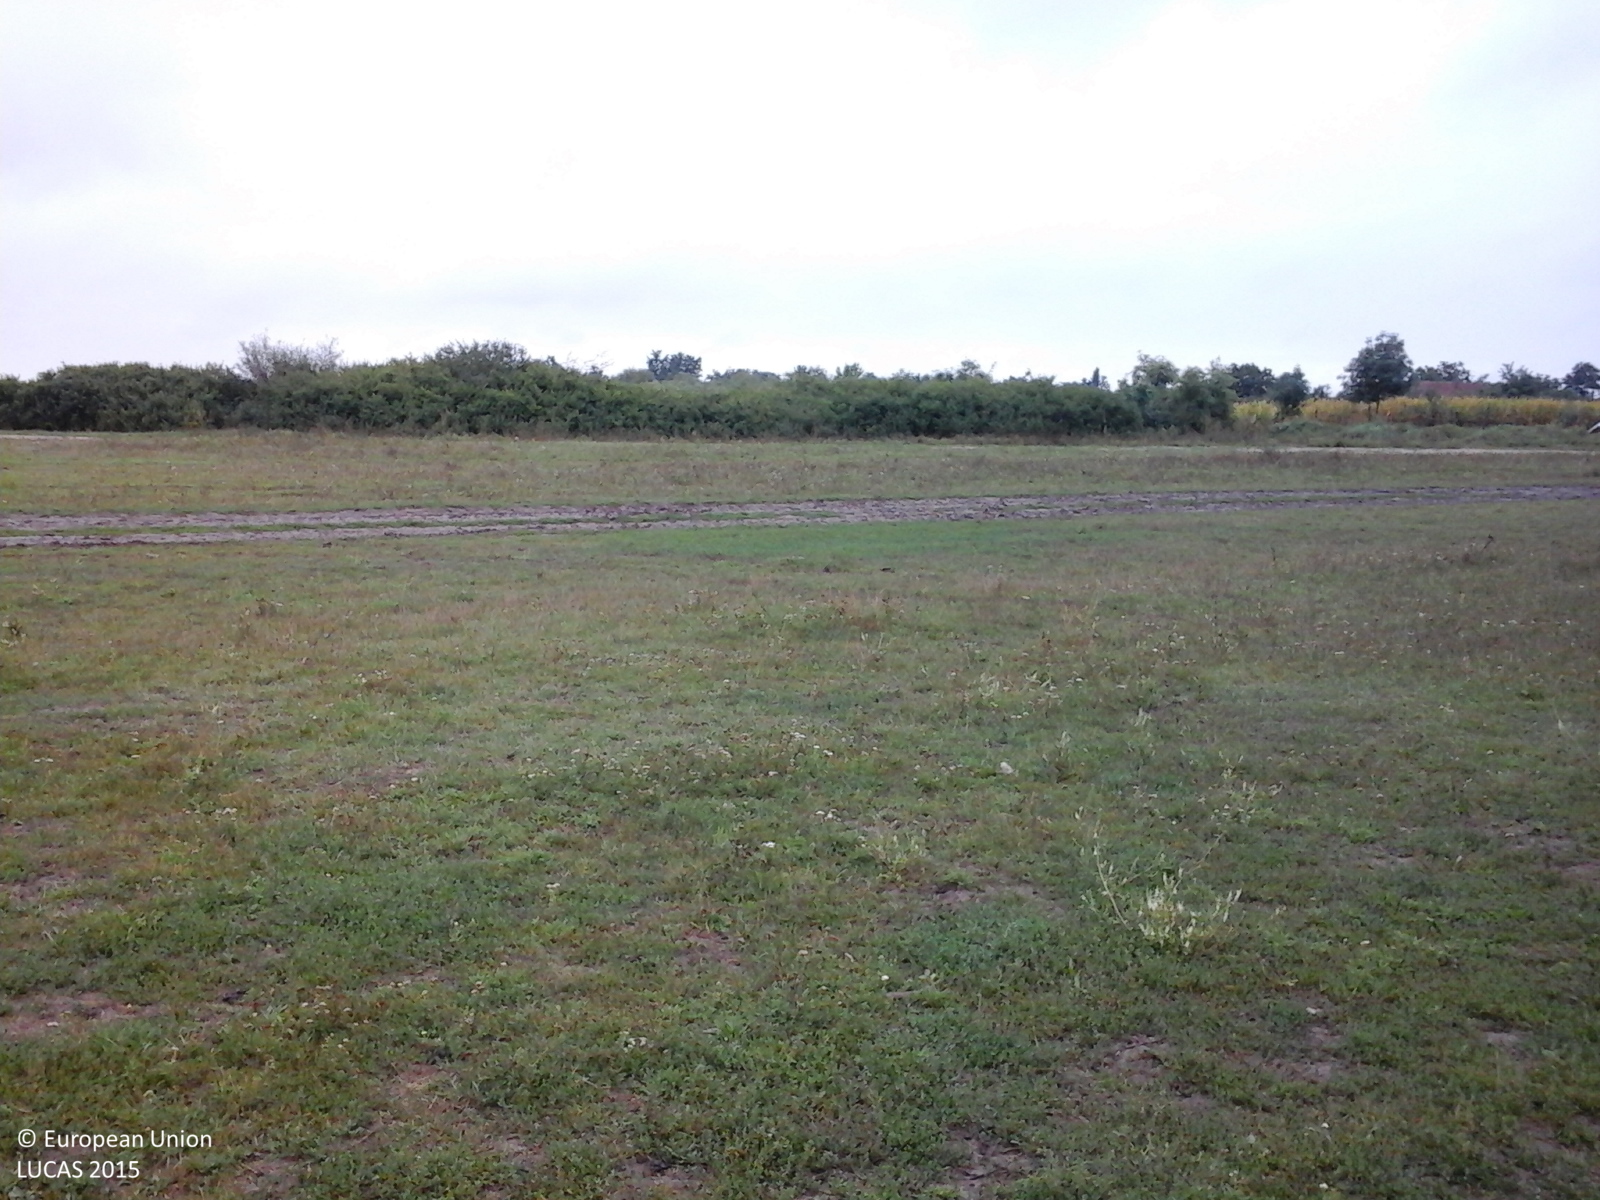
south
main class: Grassland
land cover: Grassland without tree/shrub cover
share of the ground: > 75 %
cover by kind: herbaceous plants 100 %
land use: Agriculture (excluding fallow land and kitchen gardens)
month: September
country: RO
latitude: 46.8758
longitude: 21.6536
